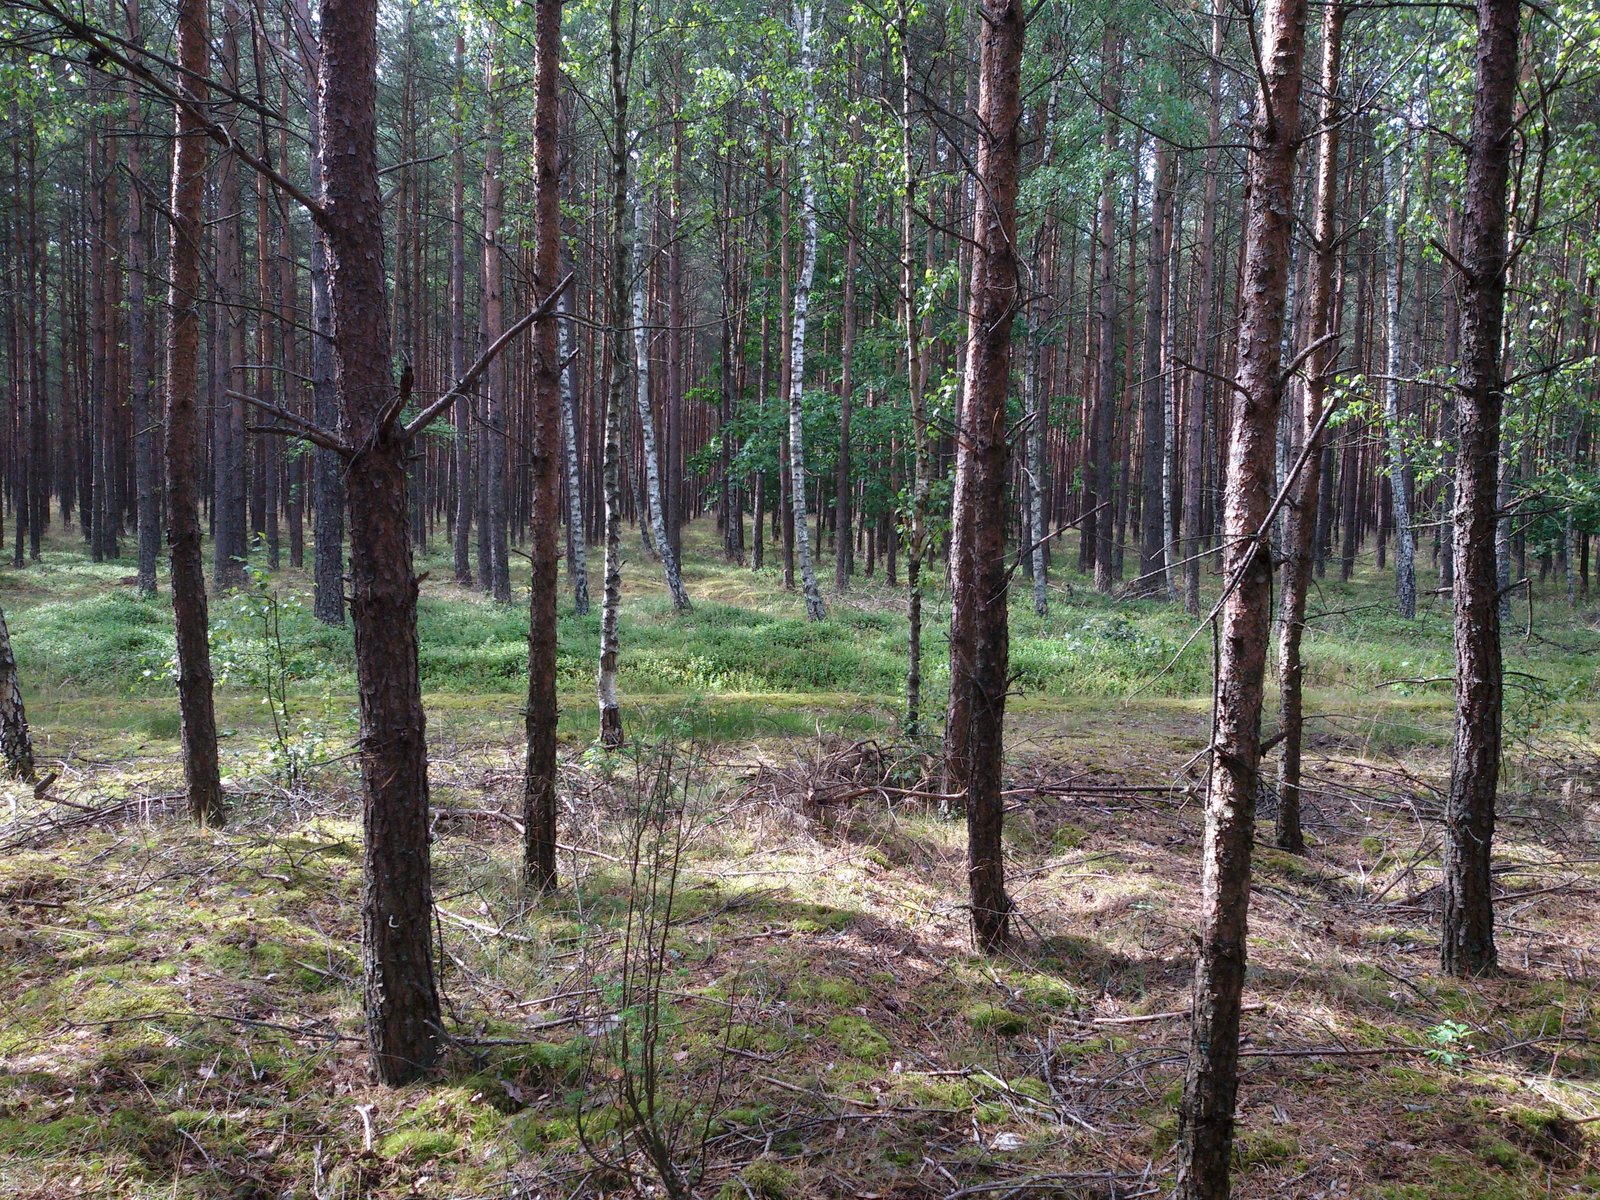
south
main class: Woodland
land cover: Pine dominated coniferous woodland
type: hemiboreal forest and nemoral coniferous forest and mixed broadleaved-coniferous forest
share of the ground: > 75 %
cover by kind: coniferous forest trees 85 %, lichens and mosses 10 %, unconsolidated bare surface 5 %
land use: Forestry
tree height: > 5 m
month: August
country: PL
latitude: 53.6427
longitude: 17.1341
